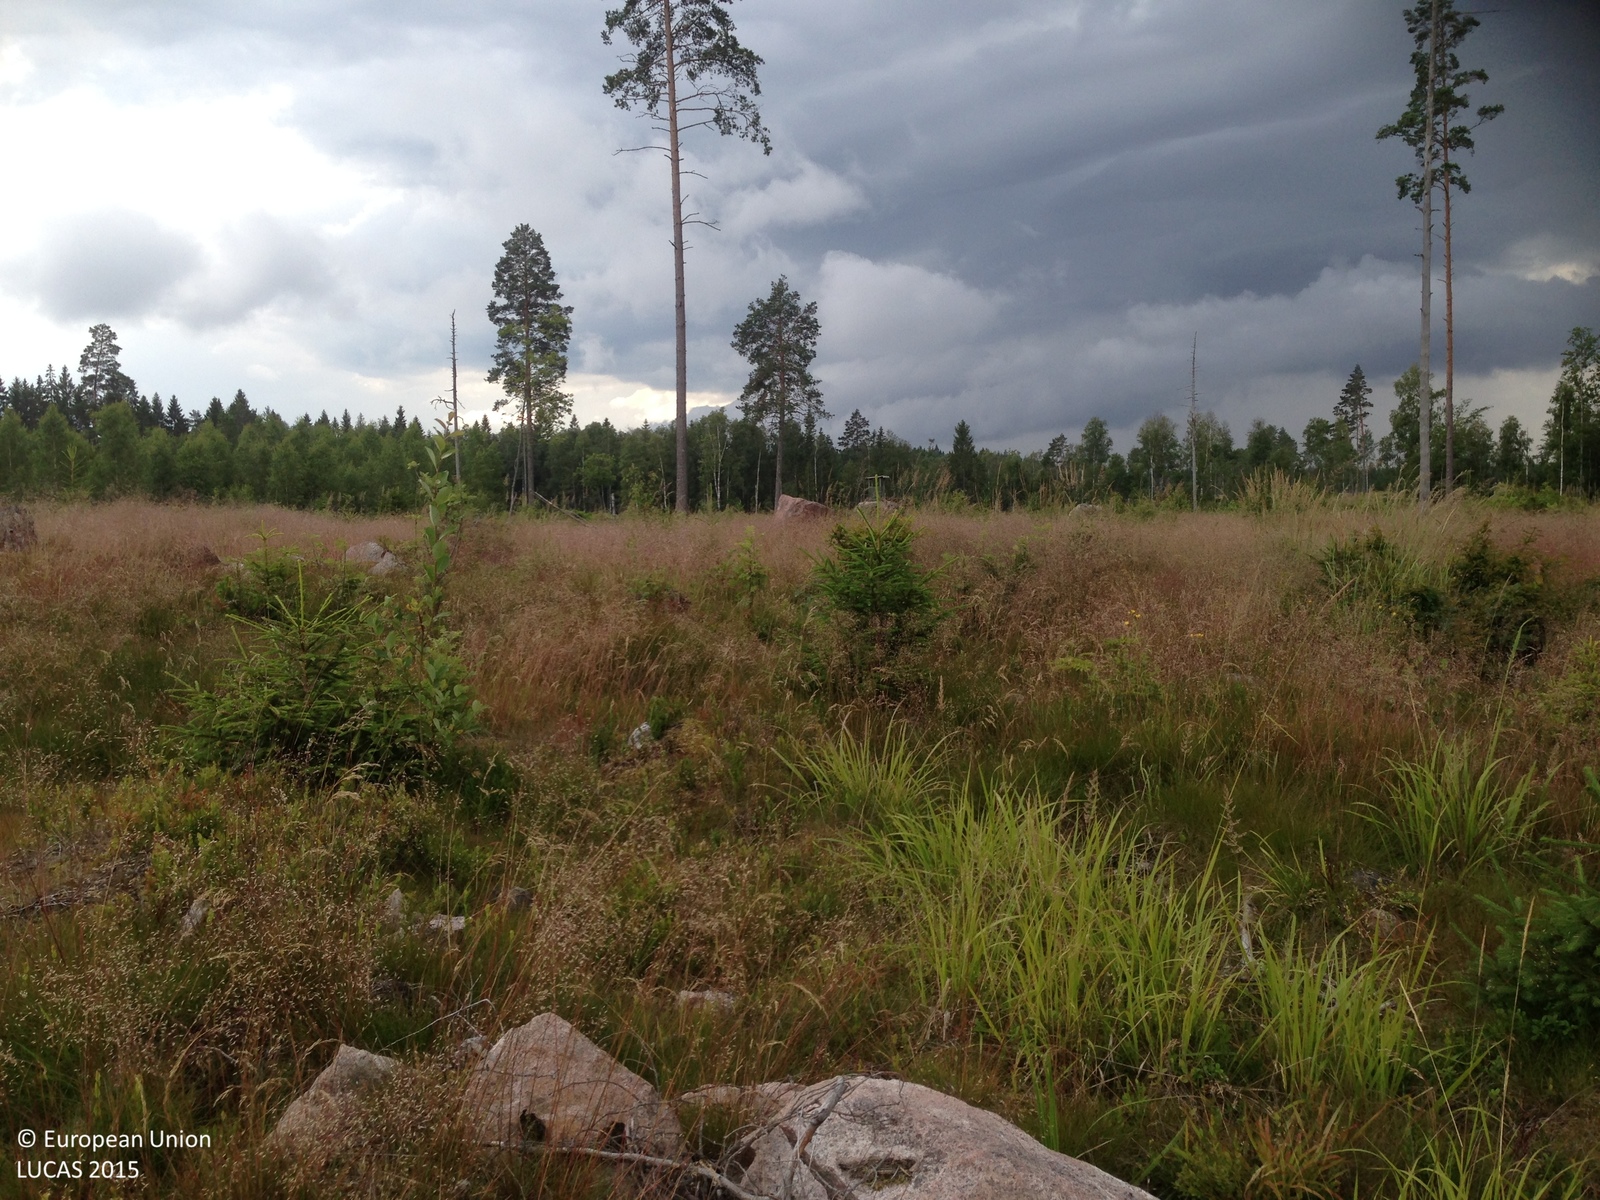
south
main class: Woodland
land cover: Broadleaved woodland
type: boreal forest
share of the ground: 10 - 25 %
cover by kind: herbaceous plants 80 %, broadleaved forest trees 15 %, coniferous forest trees 5 %
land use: Forestry
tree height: < 5 m
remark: Clear cut
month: July
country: SE
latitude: 59.9669
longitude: 18.6863
